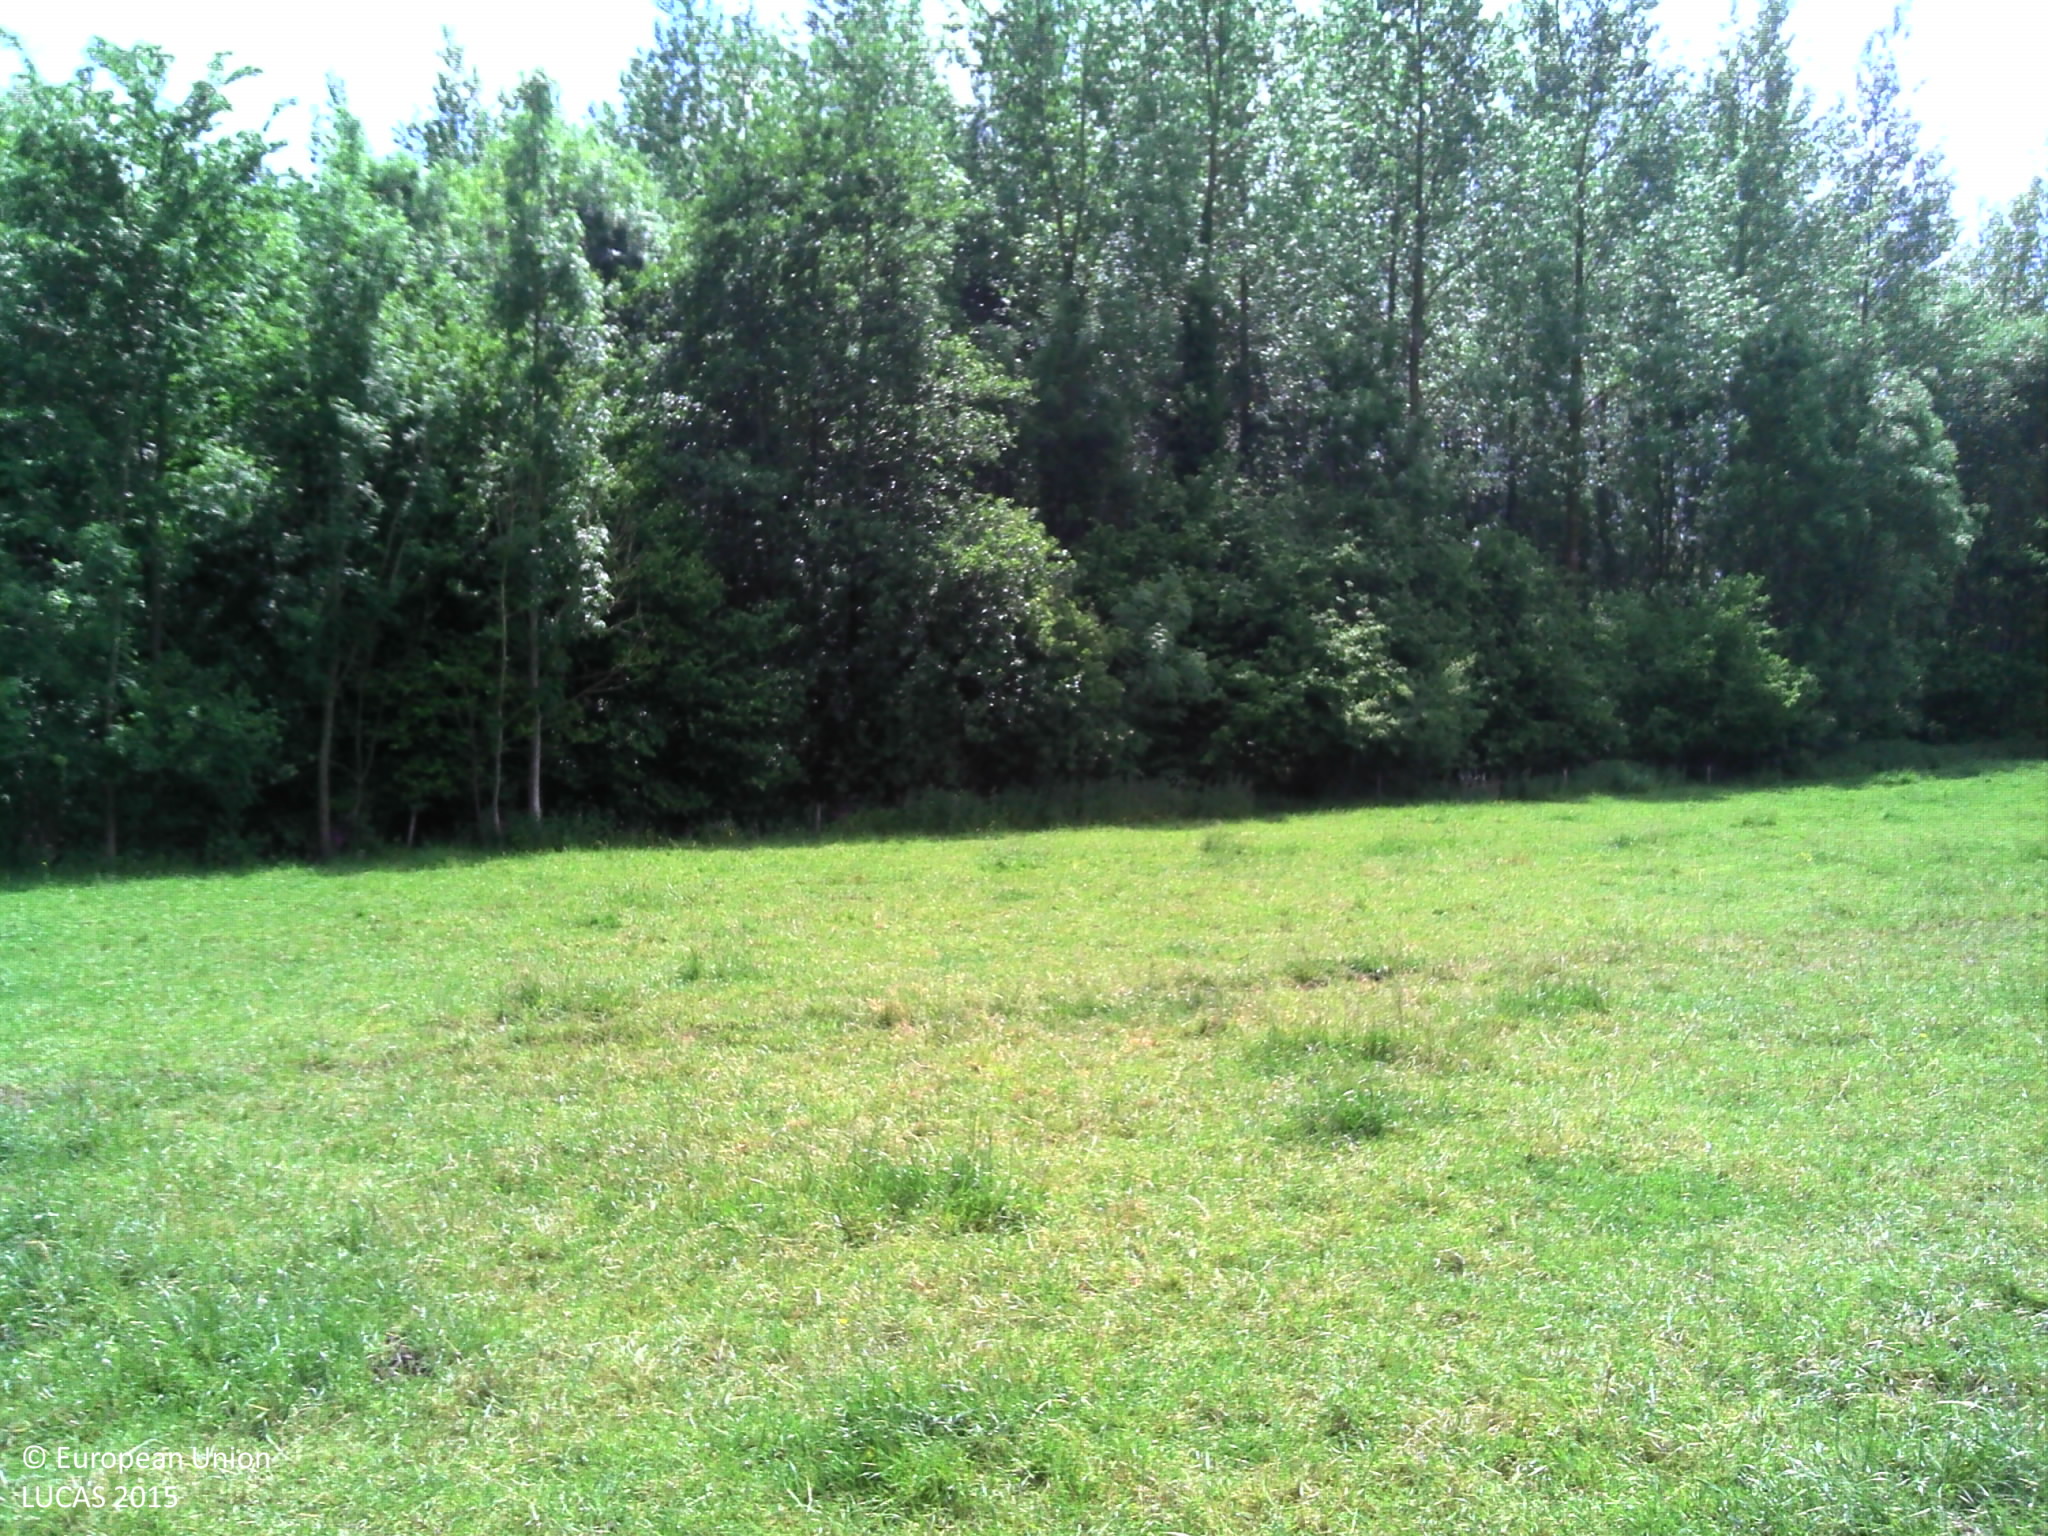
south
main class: Grassland
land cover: Grassland without tree/shrub cover
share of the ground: > 75 %
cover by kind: herbaceous plants 100 %
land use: Agriculture (excluding fallow land and kitchen gardens)
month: June
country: BE
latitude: 50.7907
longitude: 3.7942
